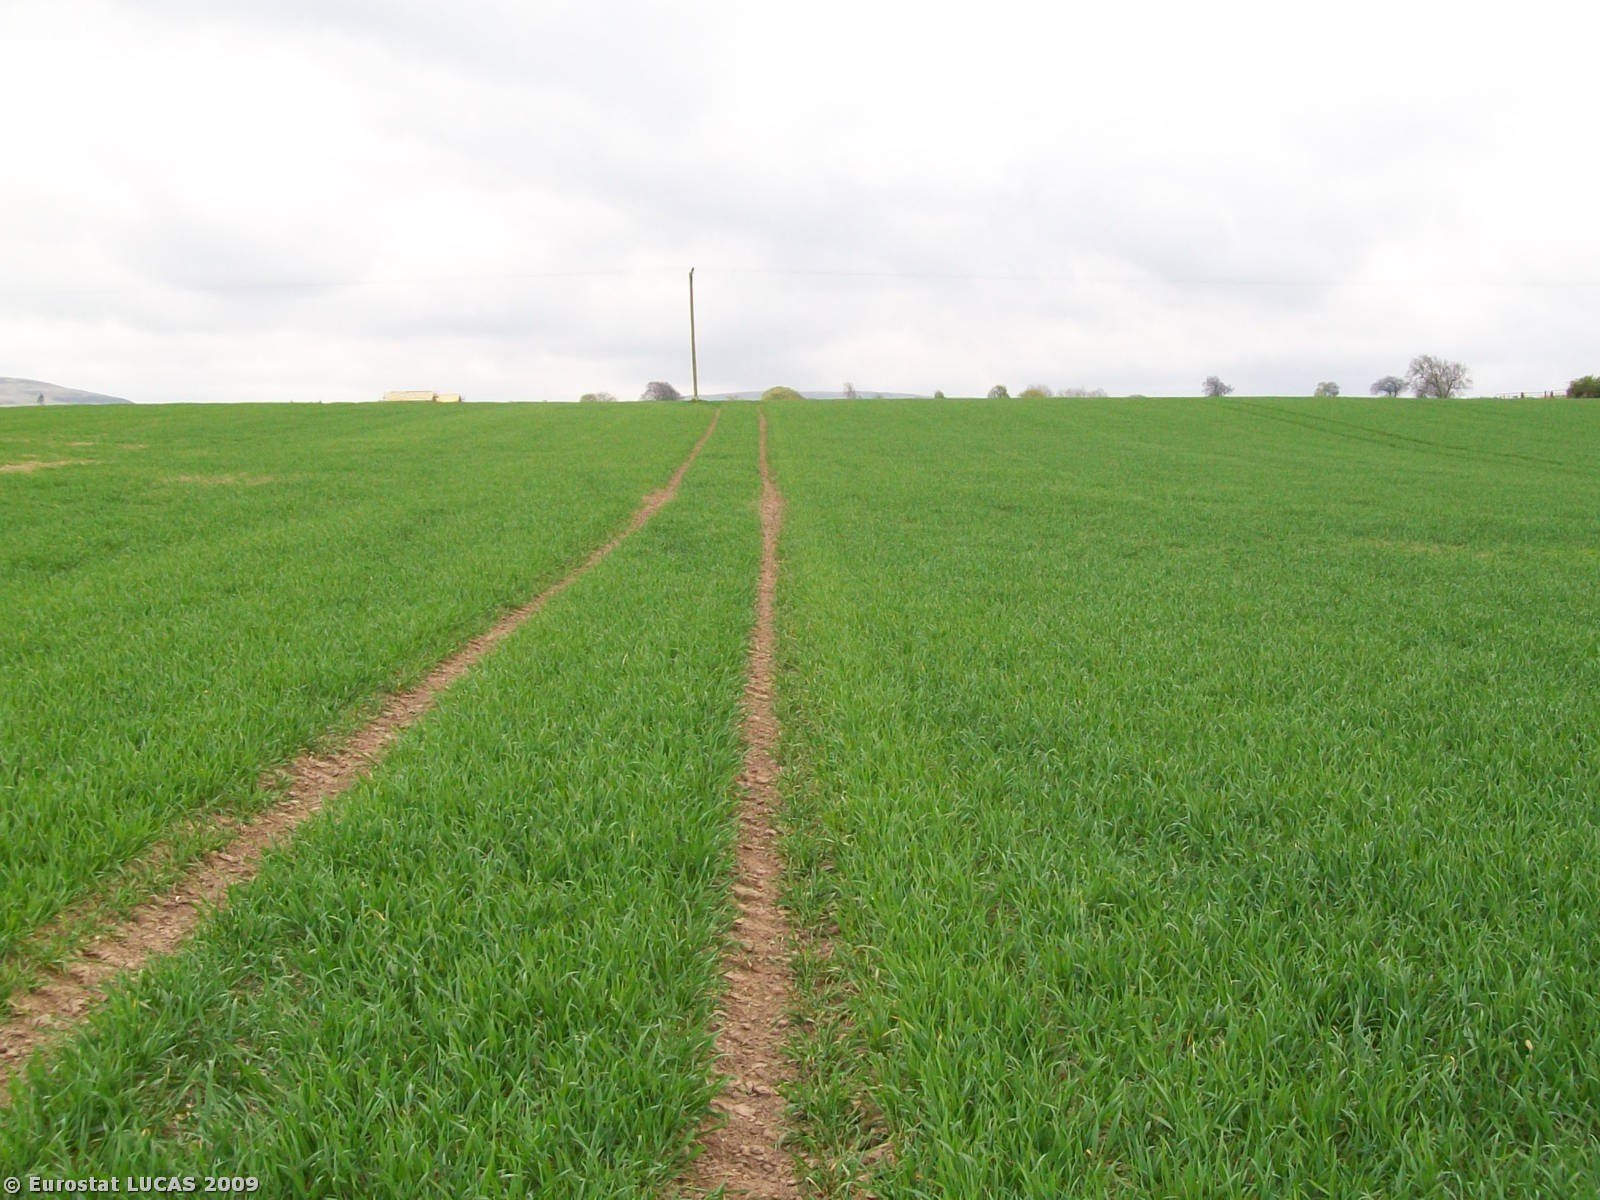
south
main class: Cropland
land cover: Common wheat
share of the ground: 50 - 75 %
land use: Agriculture (excluding fallow land and kitchen gardens)
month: April
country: GB
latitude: 56.3029
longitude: -3.7371
